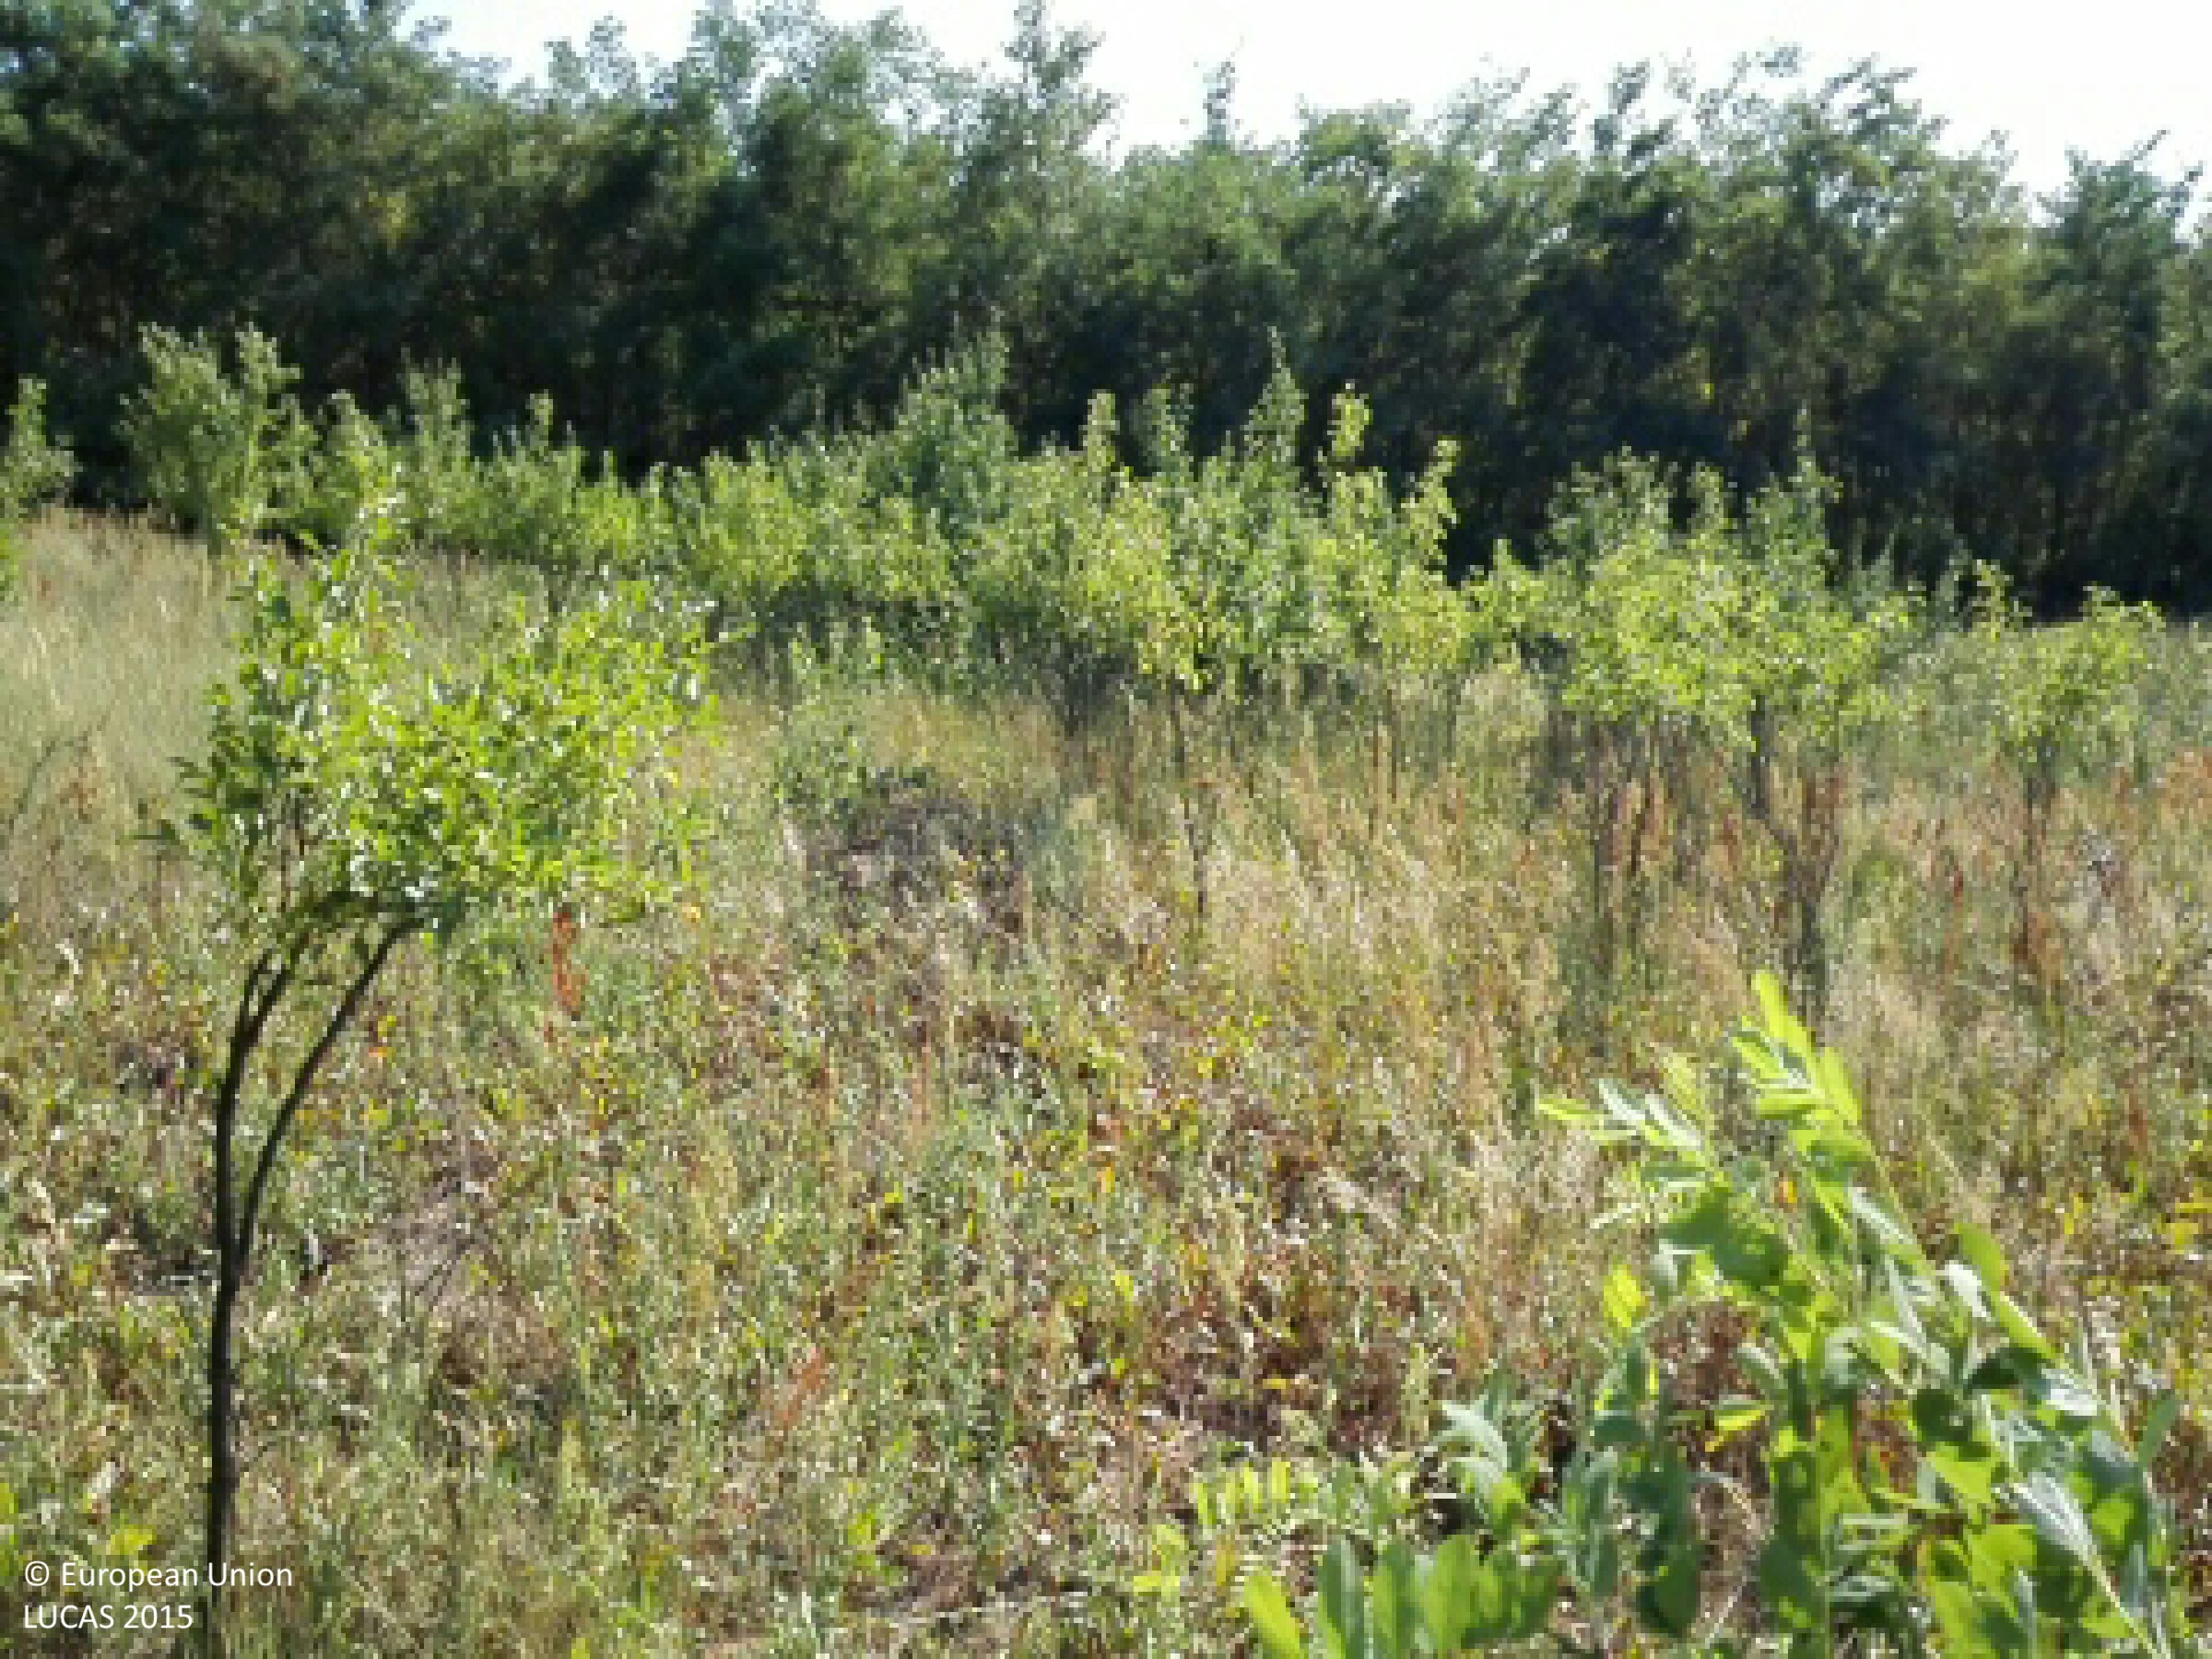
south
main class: Woodland
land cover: Broadleaved woodland
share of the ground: > 75 %
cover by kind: broadleaved forest trees 40 %, shrubs 30 %, herbaceous plants 30 %
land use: Semi-natural and natural areas not in use
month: July
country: HU
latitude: 47.6943
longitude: 21.6512
